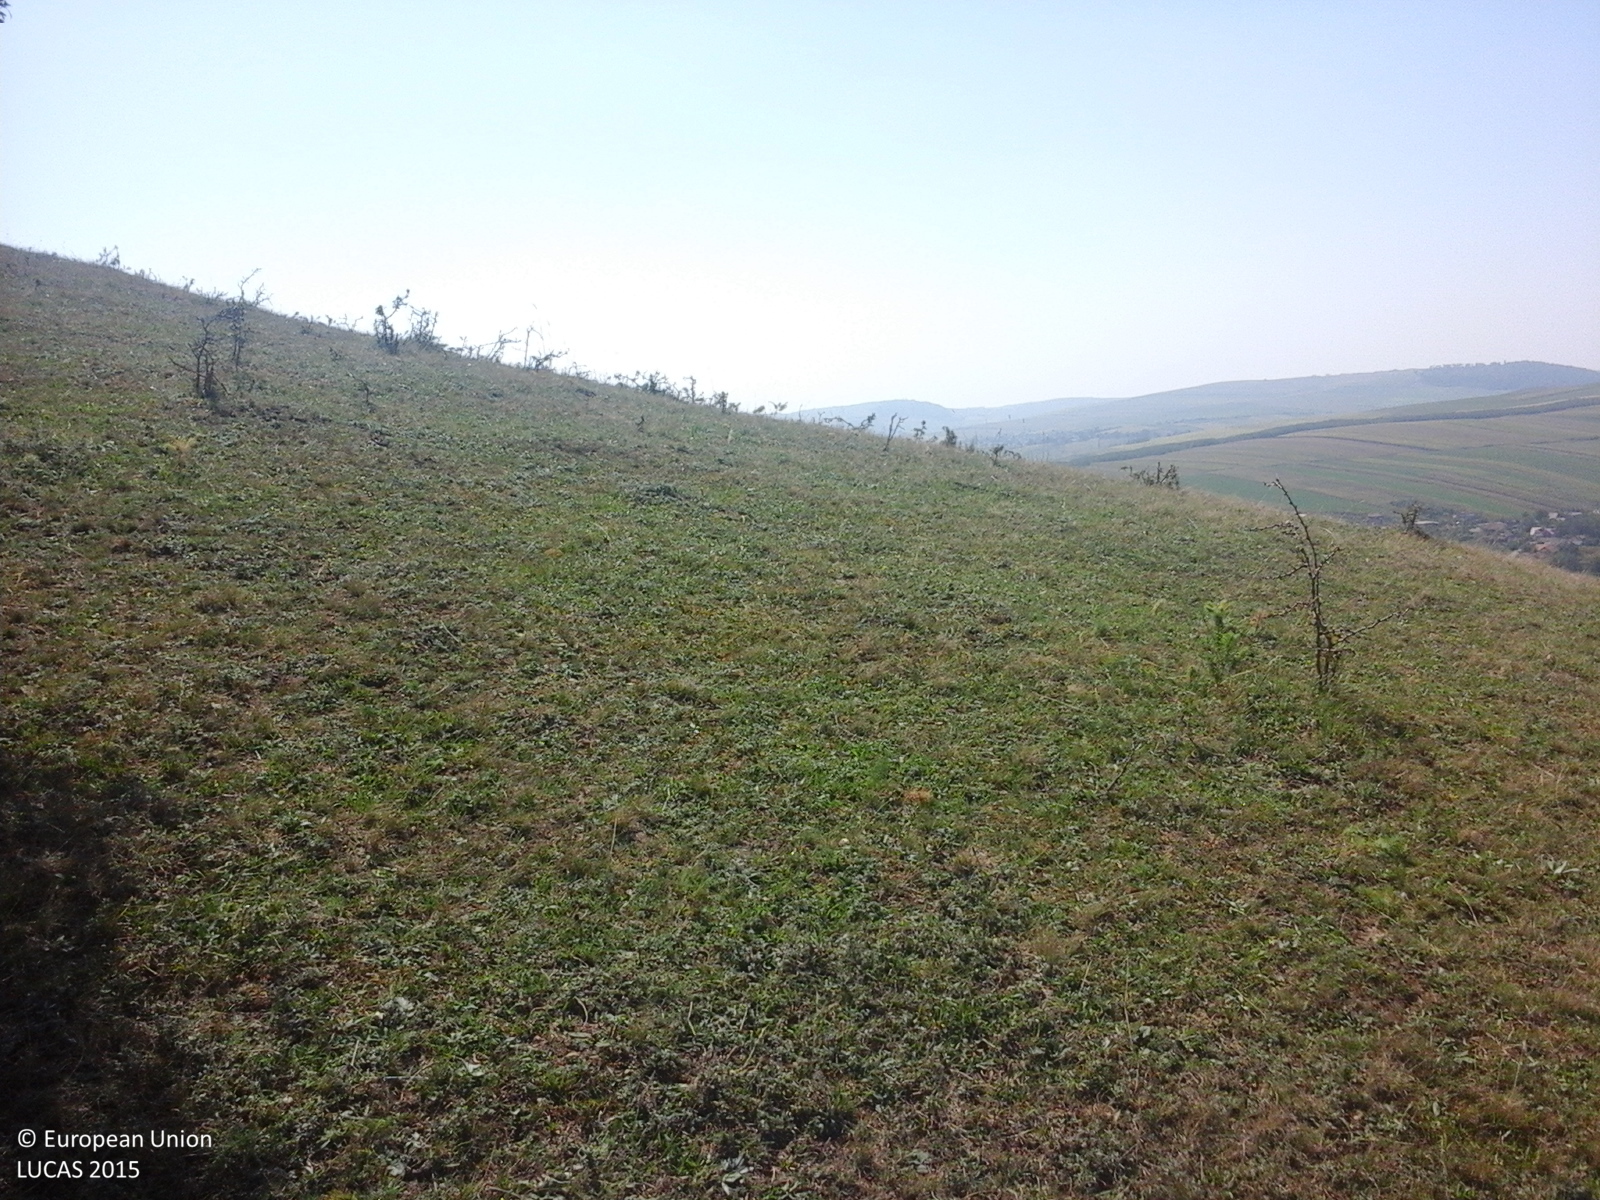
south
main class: Grassland
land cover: Grassland with sparse tree/shrub cover
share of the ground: > 75 %
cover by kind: herbaceous plants 95 %, broadleaved forest trees 5 %
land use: Fallow land
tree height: < 5 m
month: September
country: RO
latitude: 46.7217
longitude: 24.4129
